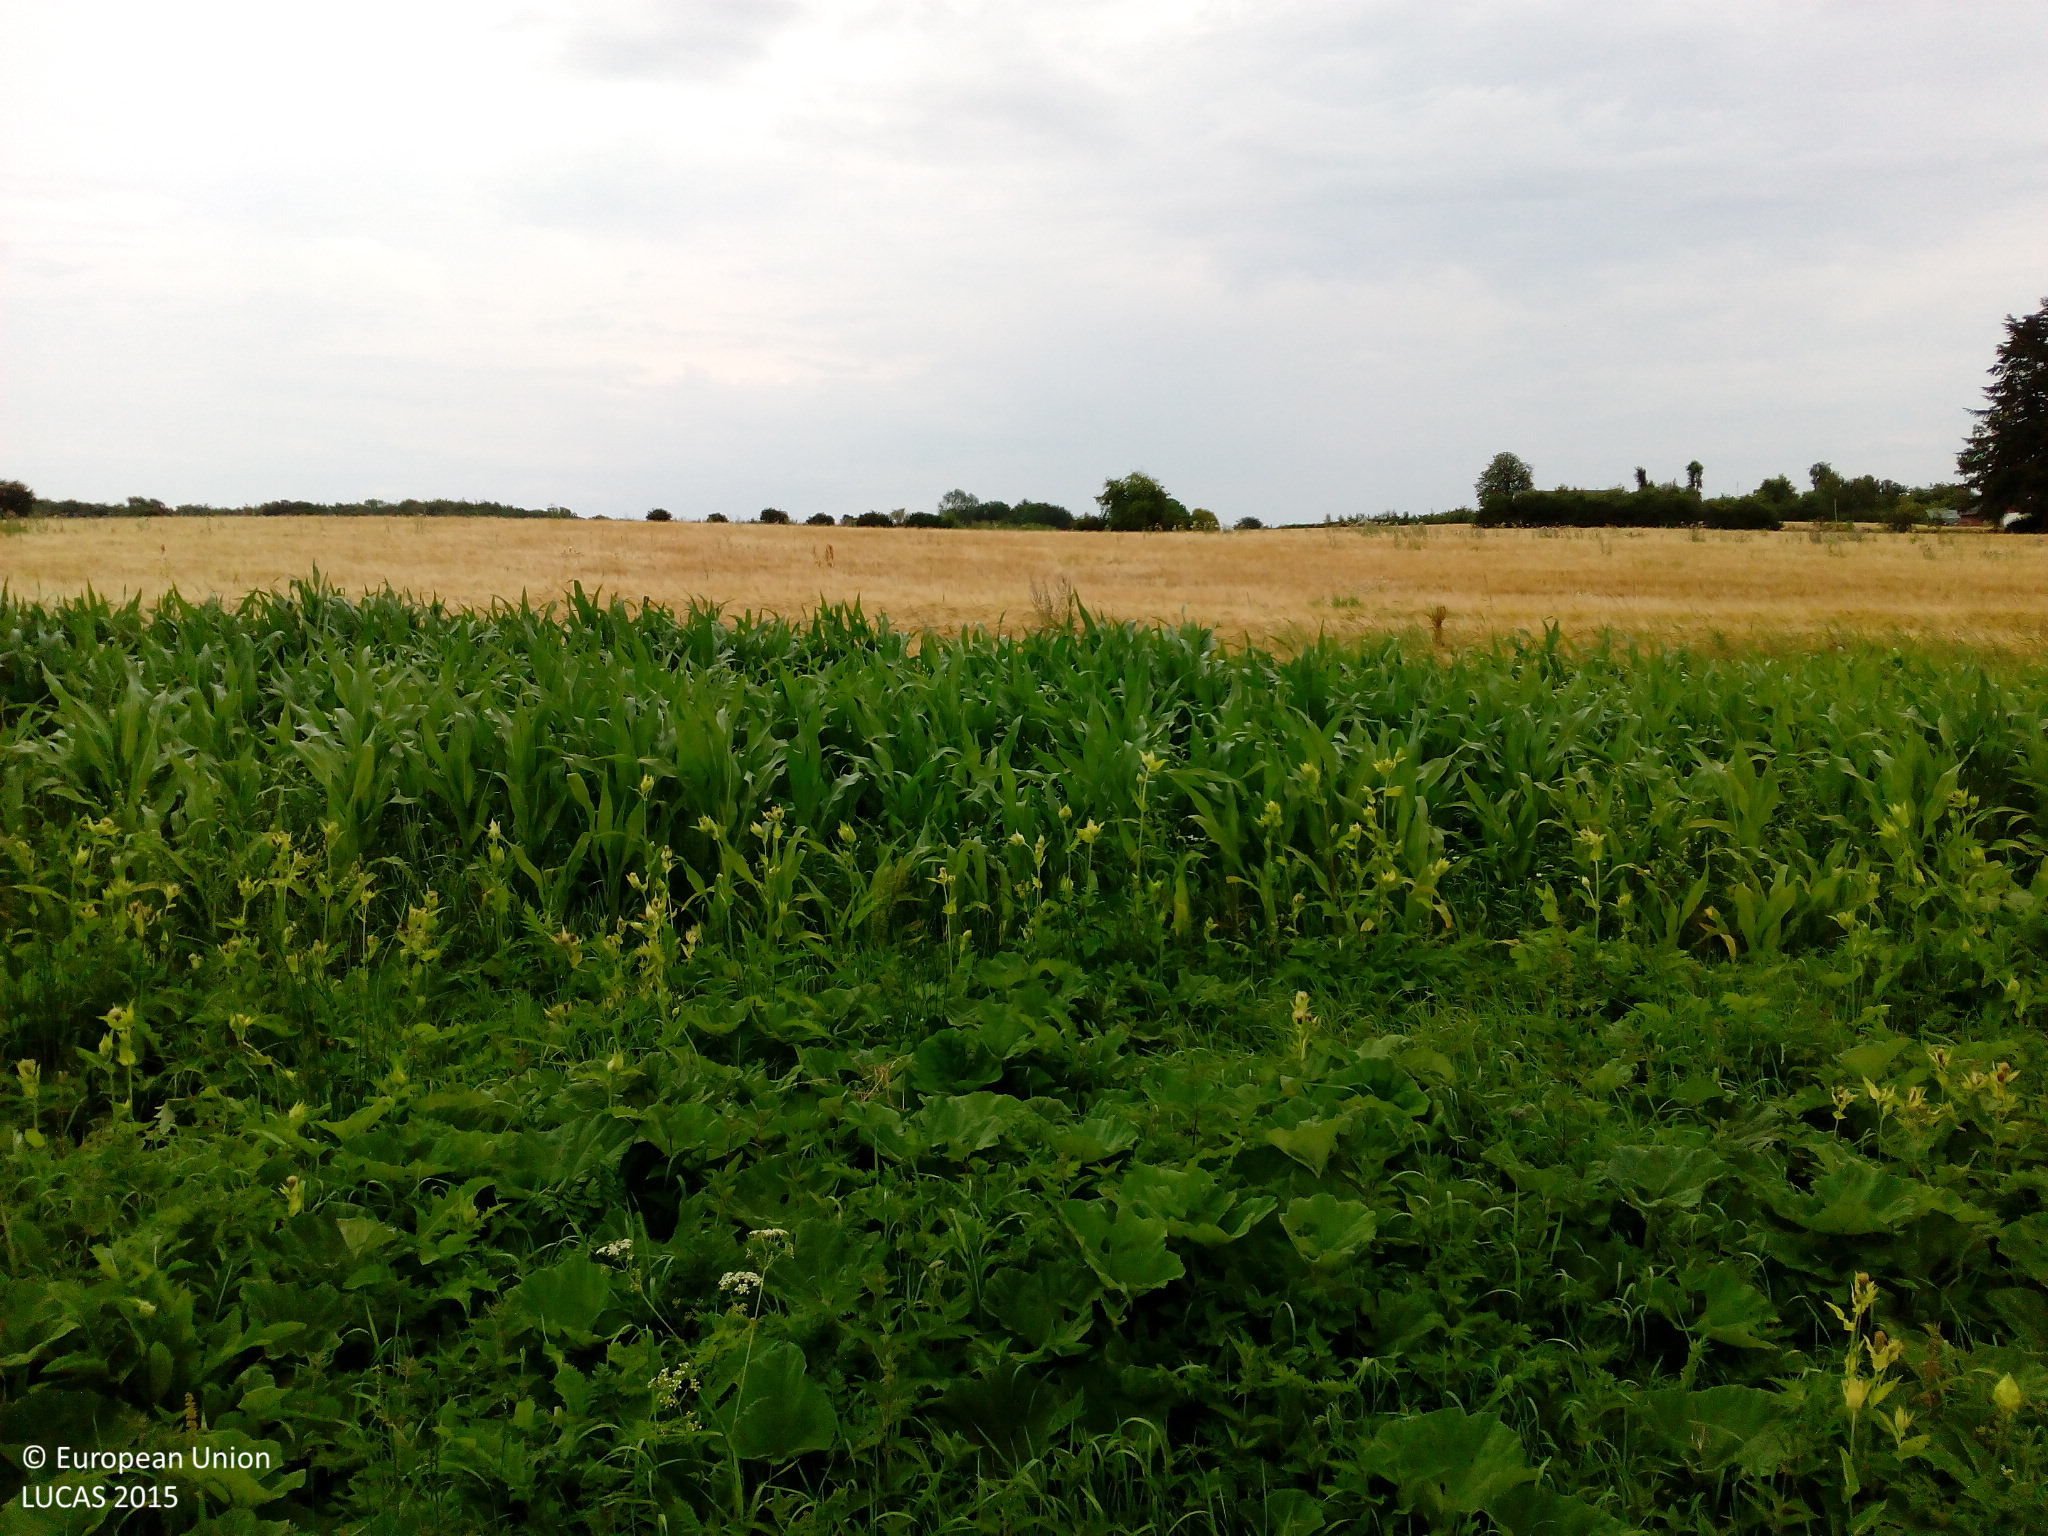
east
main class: Grassland
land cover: Grassland without tree/shrub cover
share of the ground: > 75 %
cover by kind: herbaceous plants 100 %
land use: Semi-natural and natural areas not in use
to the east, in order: Grassland without tree/shrub cover; Maize; Barley; Shruby margins; Grass margins; Abandoned hedges; Barley
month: August
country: DK
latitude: 55.5252
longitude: 11.9785
